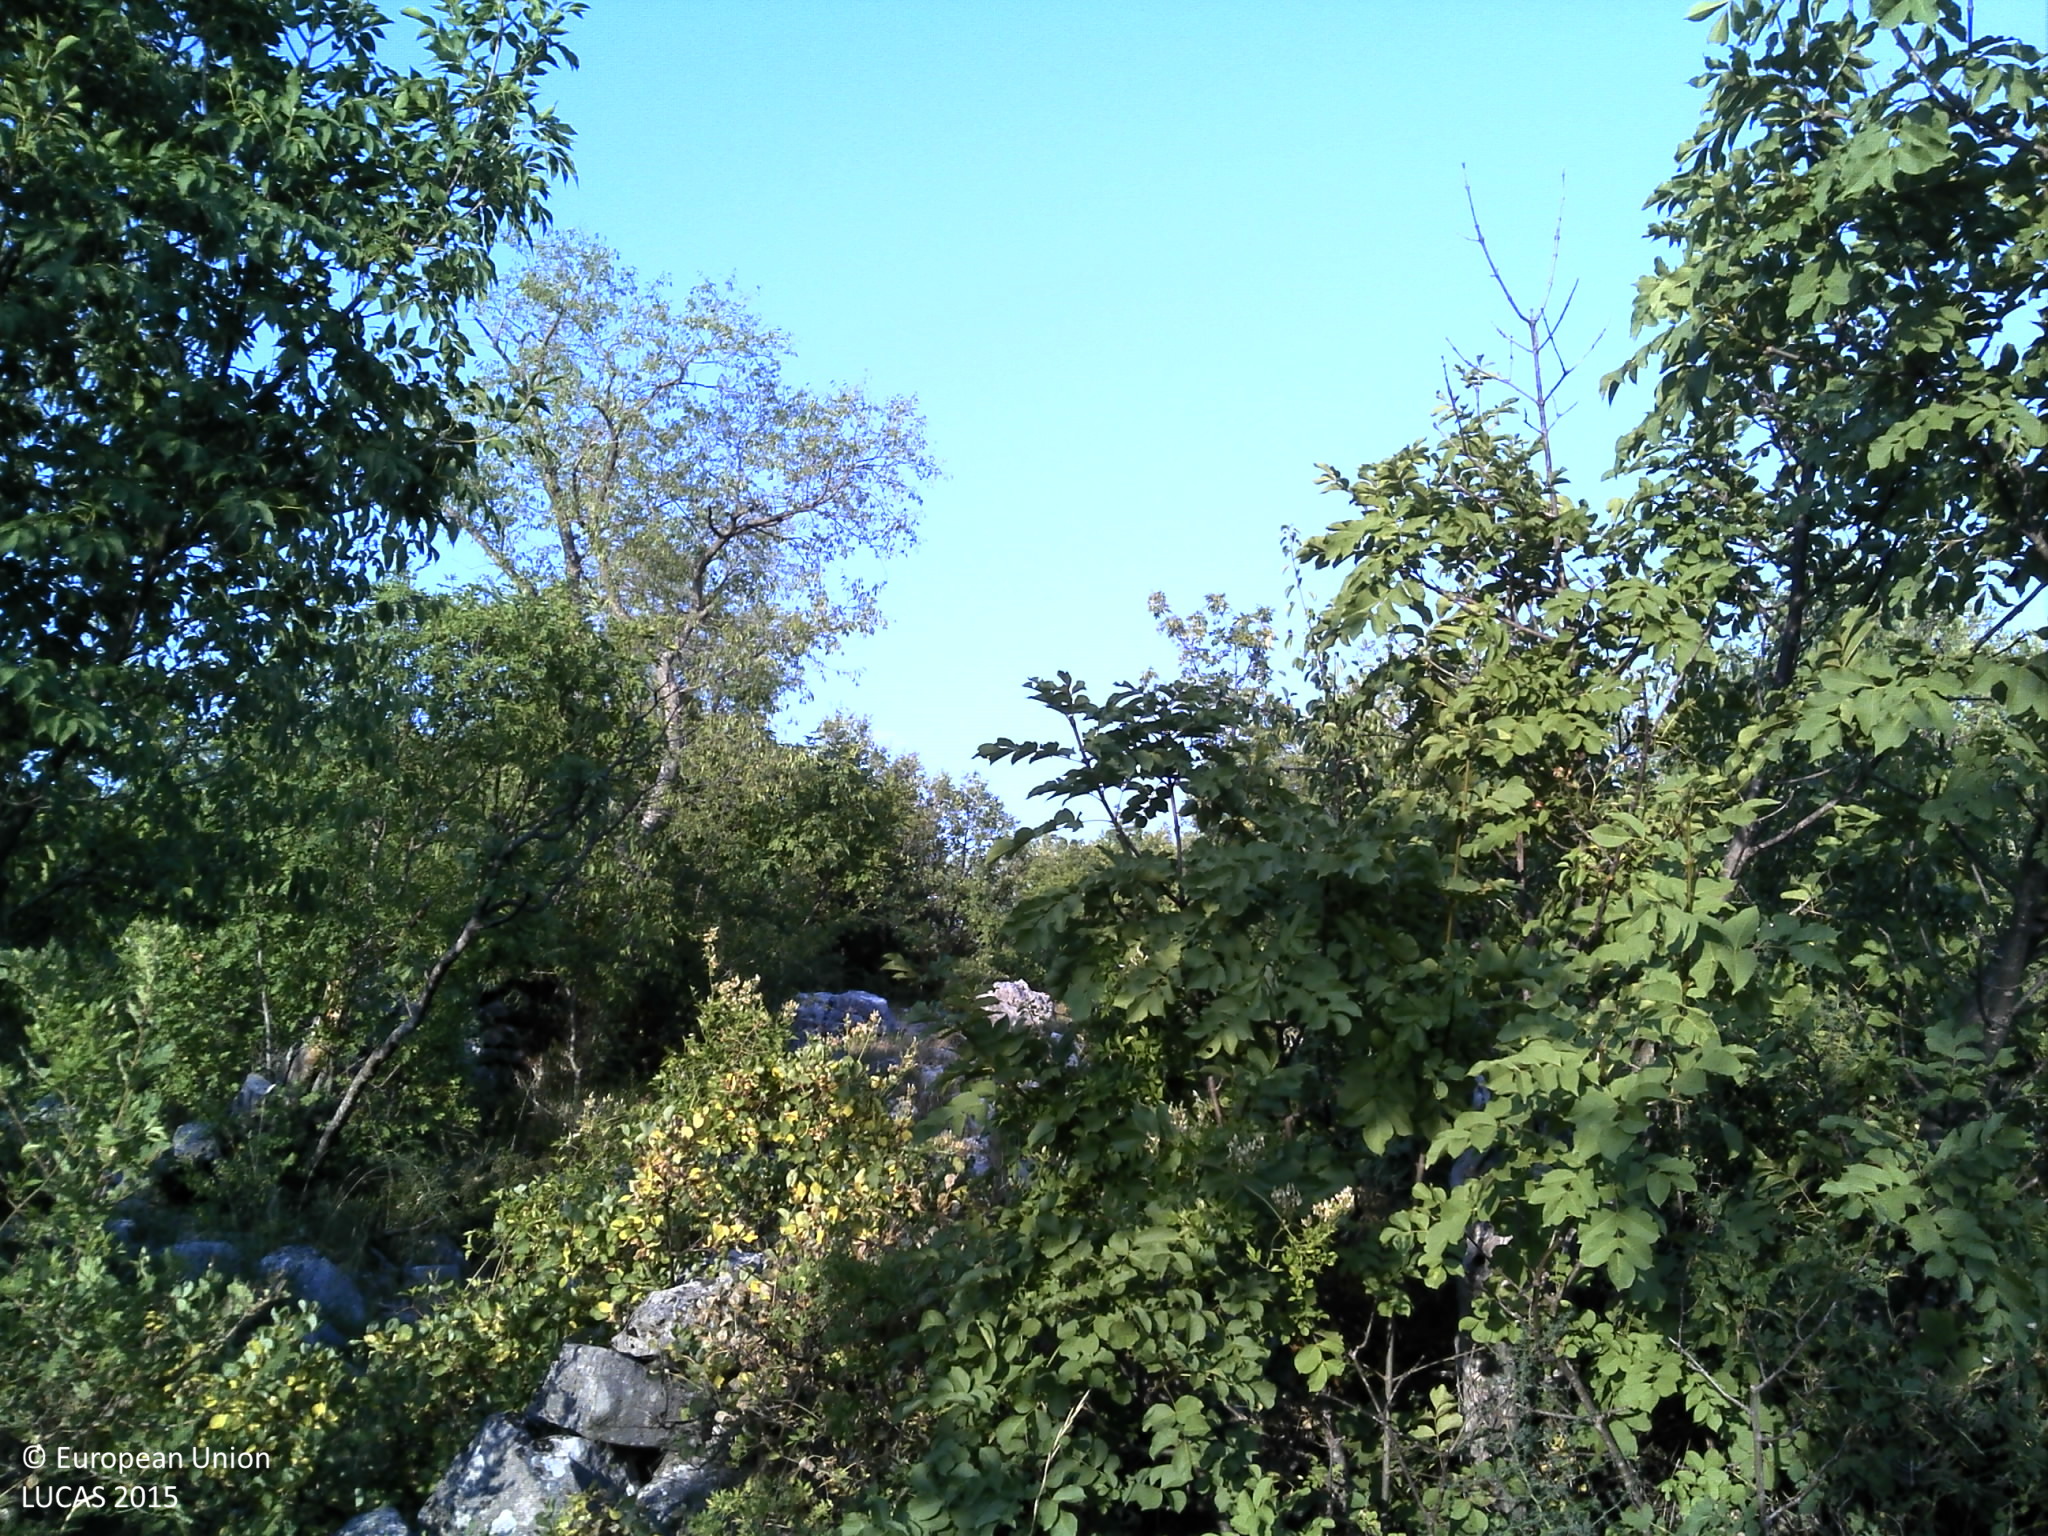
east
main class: Woodland
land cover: Broadleaved woodland
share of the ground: 10 - 25 %
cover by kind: shrubs 30 %, broadleaved forest trees 25 %, unconsolidated bare surface 25 %, herbaceous plants 20 %
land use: Semi-natural and natural areas not in use
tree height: > 5 m
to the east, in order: Broadleaved woodland; Dry stone walls; Broadleaved woodland; Dry stone walls; Tracks; Dry stone walls; Other fruit trees and berries; Dry stone walls; Rock outcrops; Broadleaved woodland
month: July
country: HR
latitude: 43.8891
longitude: 16.2782
